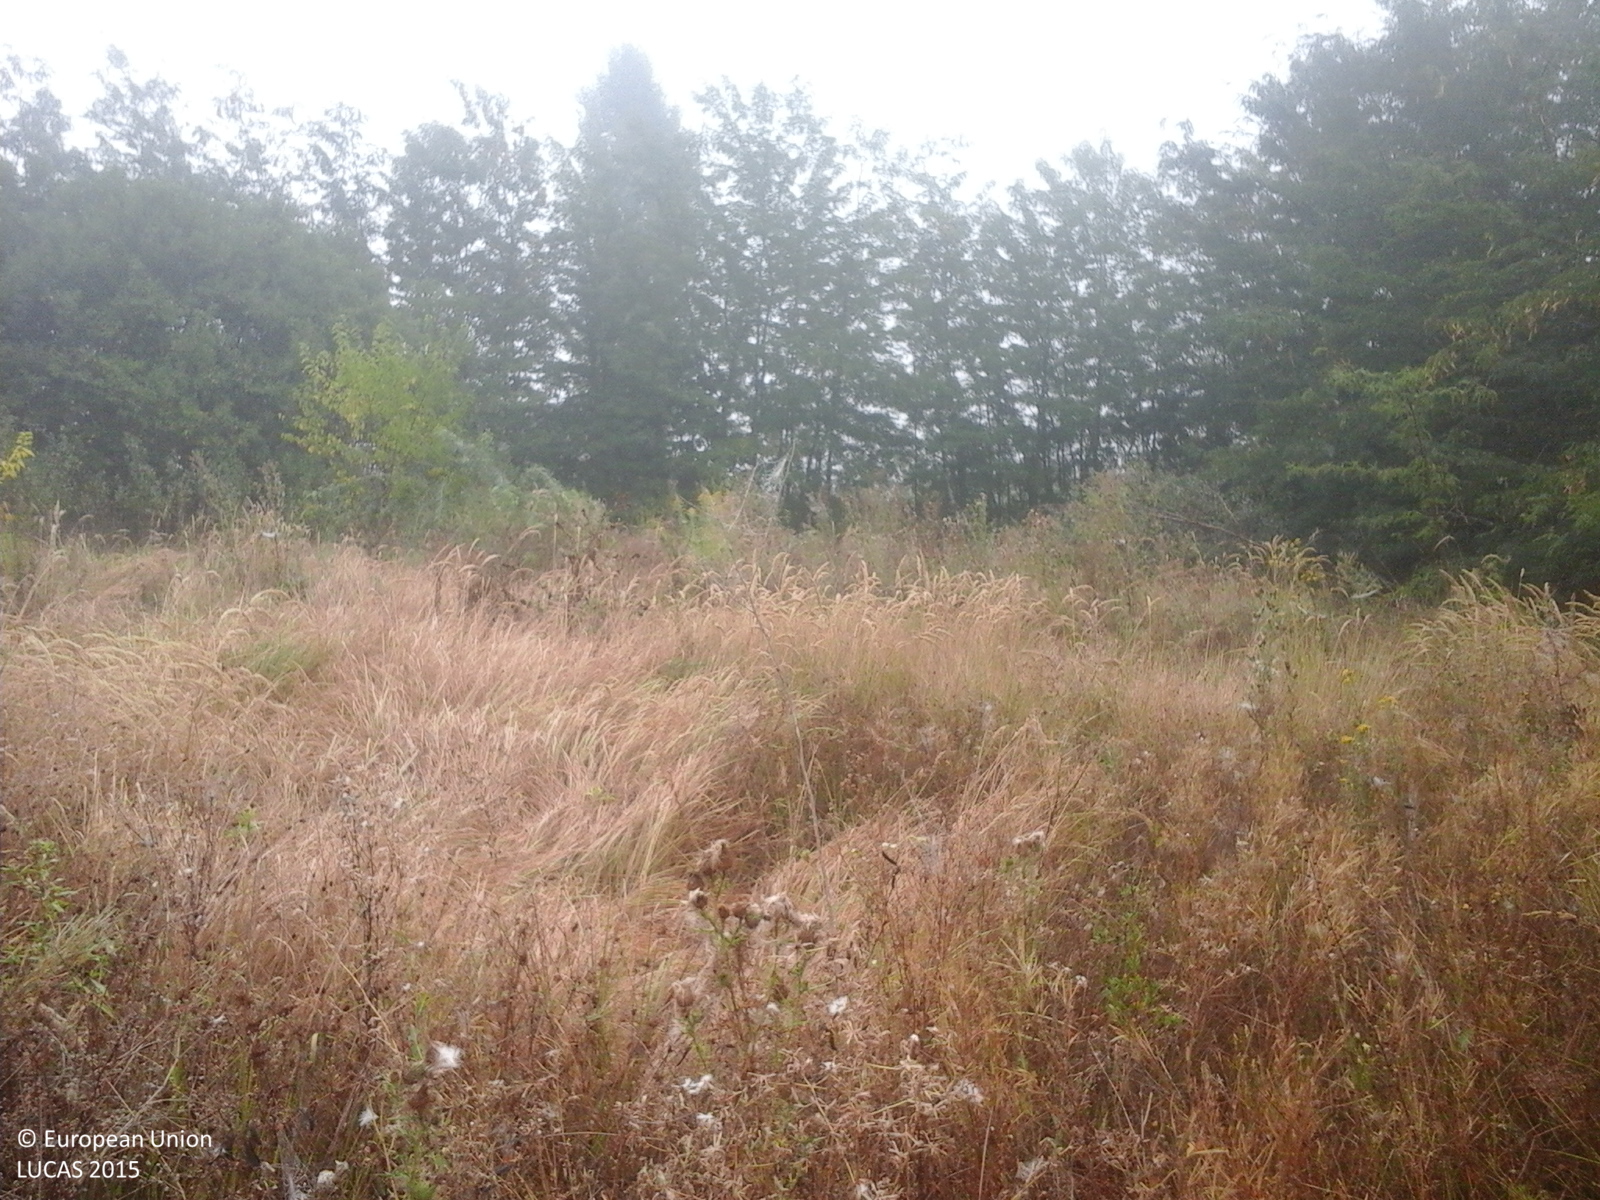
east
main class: Grassland
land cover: Spontaneously vegetated surfaces
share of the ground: > 75 %
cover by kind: herbaceous plants 100 %
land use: Fallow land
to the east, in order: Spontaneously vegetated surfaces; Abandoned hedges; Artificial constructions in urban areas; Maize; Arable land (only in case pi); Grass margins; Maize
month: September
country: RO
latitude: 47.9580
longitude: 23.0176
